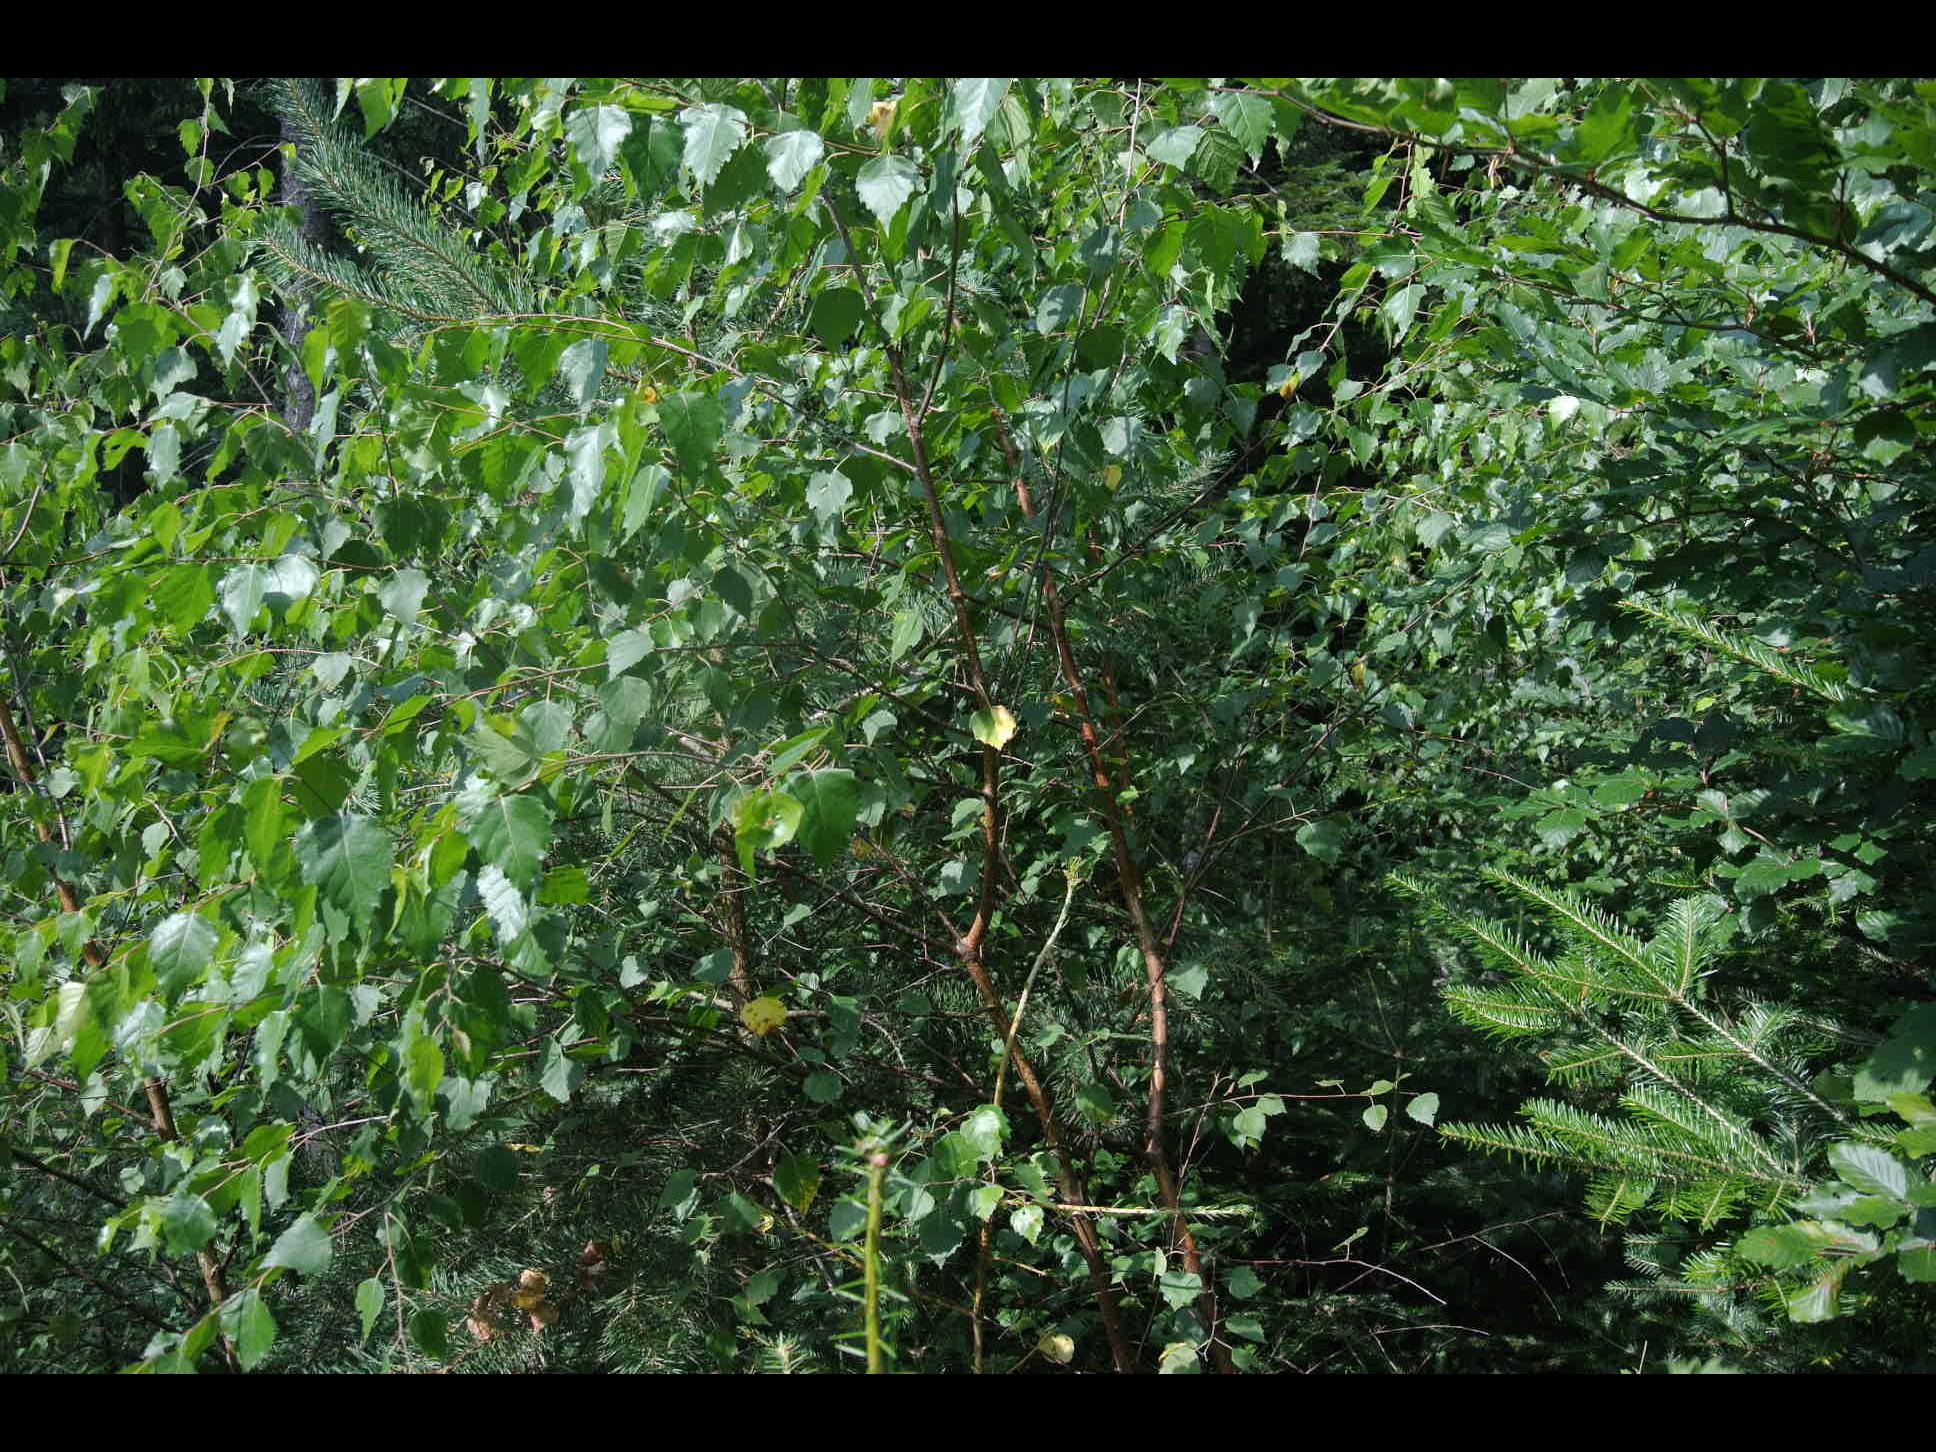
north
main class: Woodland
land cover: Spruce dominated mixed woodland
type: alpine coniferous forest
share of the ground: > 75 %
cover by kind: broadleaved forest trees 60 %, coniferous forest trees 40 %
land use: Forestry
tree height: < 5 m
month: July
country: AT
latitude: 47.5821
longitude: 16.1589
